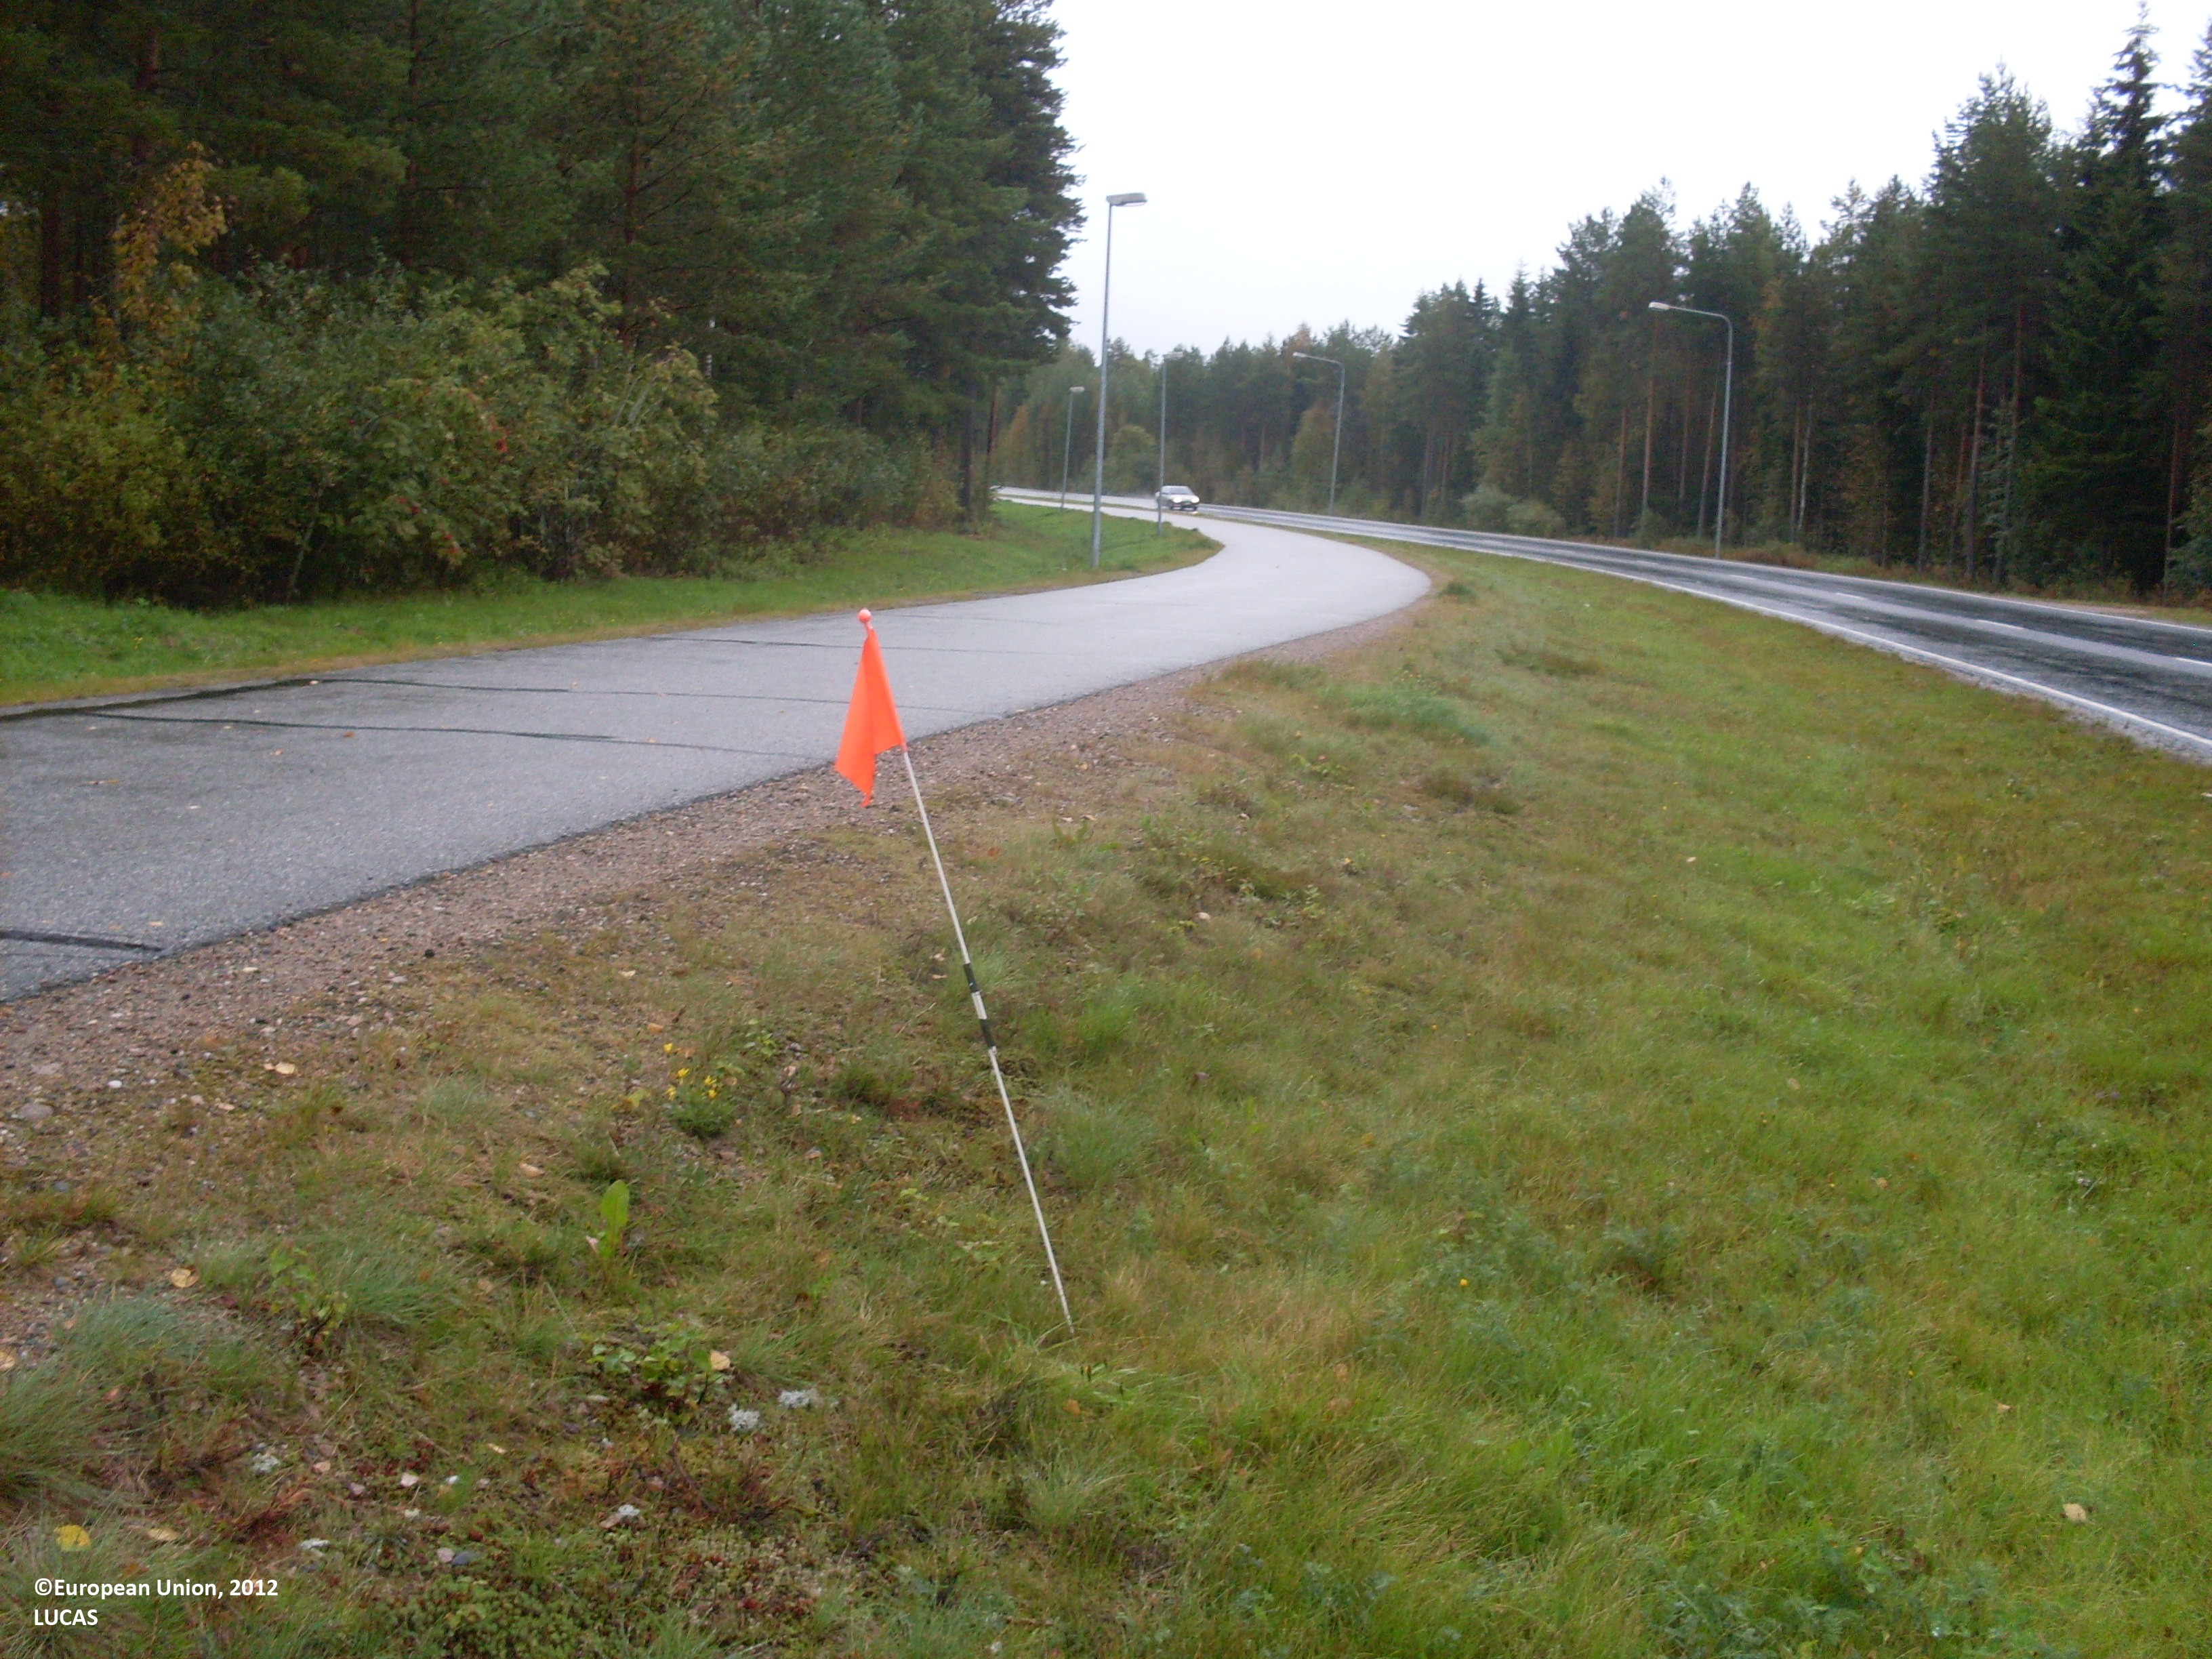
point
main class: Grassland
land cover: Grassland without tree/shrub cover
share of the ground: > 75 %
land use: Road transport
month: September
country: FI
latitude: 64.1183
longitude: 29.5417
